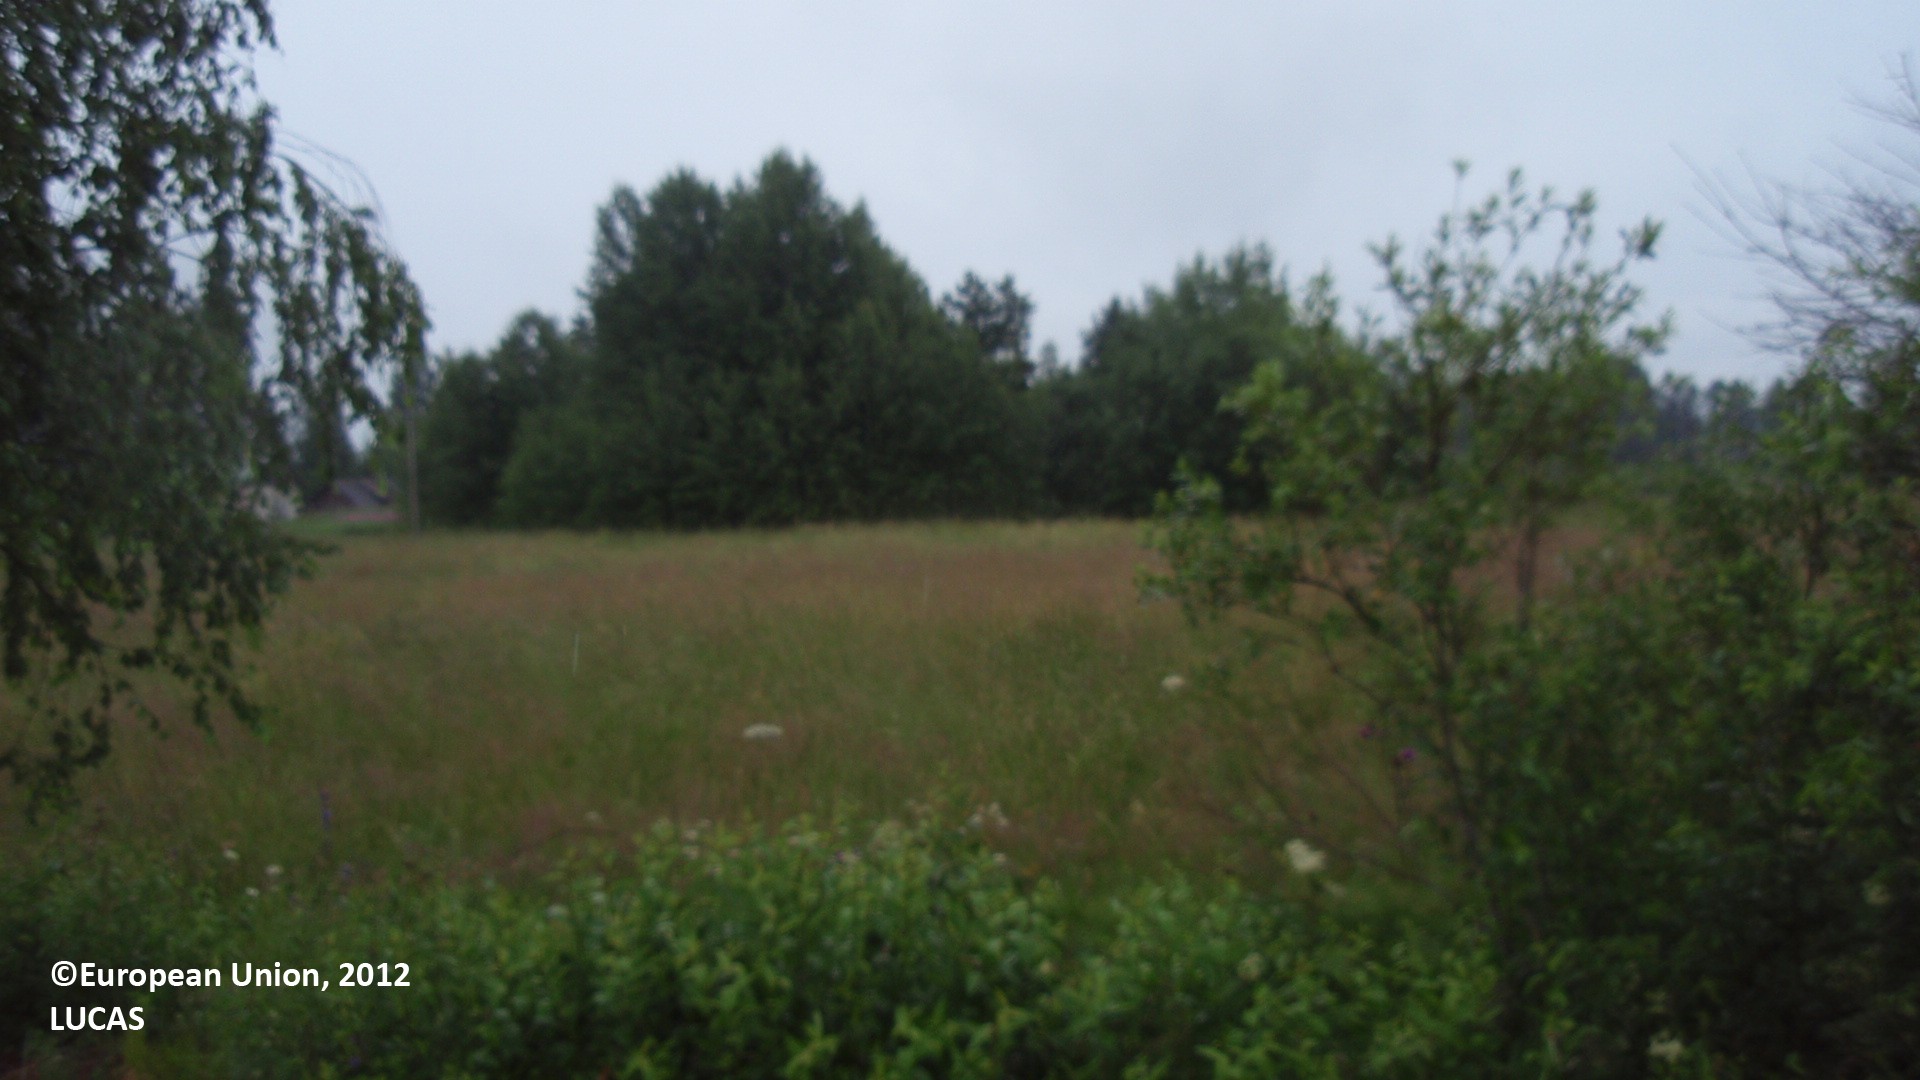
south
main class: Cropland
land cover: Oats
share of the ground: > 75 %
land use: Agriculture (excluding fallow land and kitchen gardens)
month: July
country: FI
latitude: 61.0987
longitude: 28.7551
